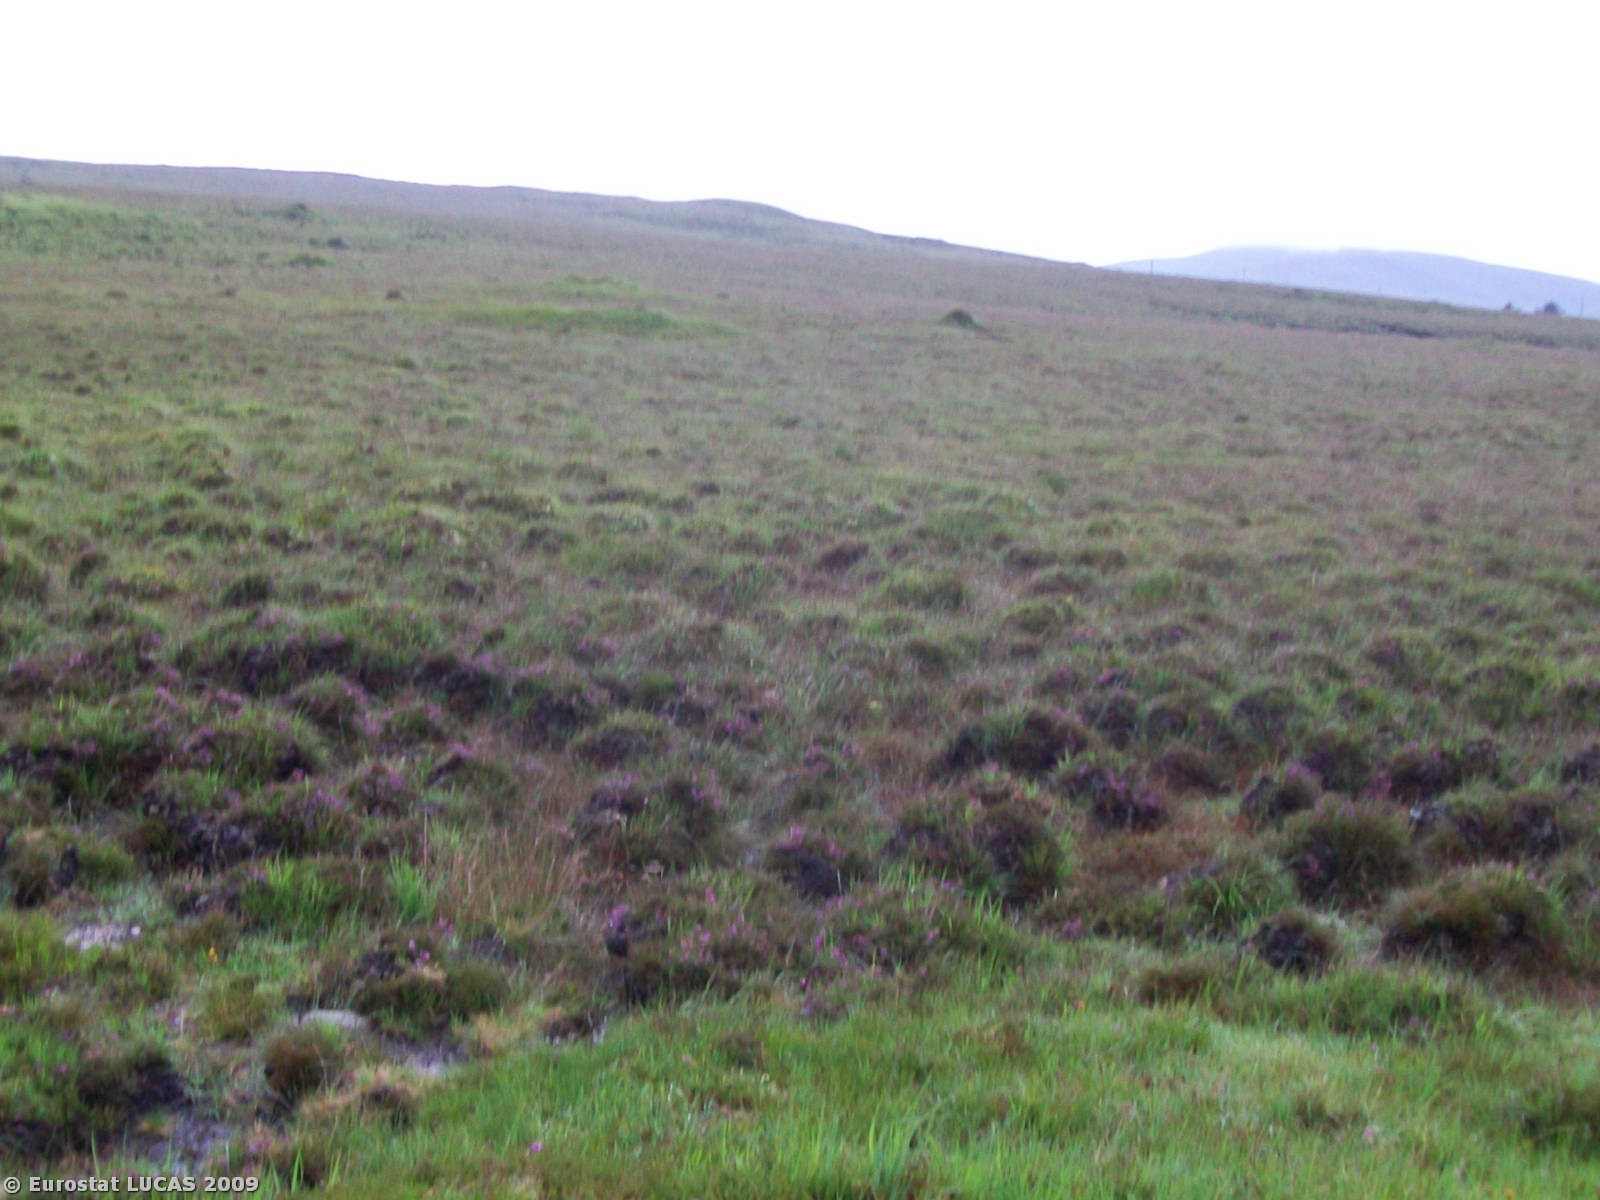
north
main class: Wetlands
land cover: Peatbogs
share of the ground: > 75 %
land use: Unused
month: July
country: IE
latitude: 54.0078
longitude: -9.7901
